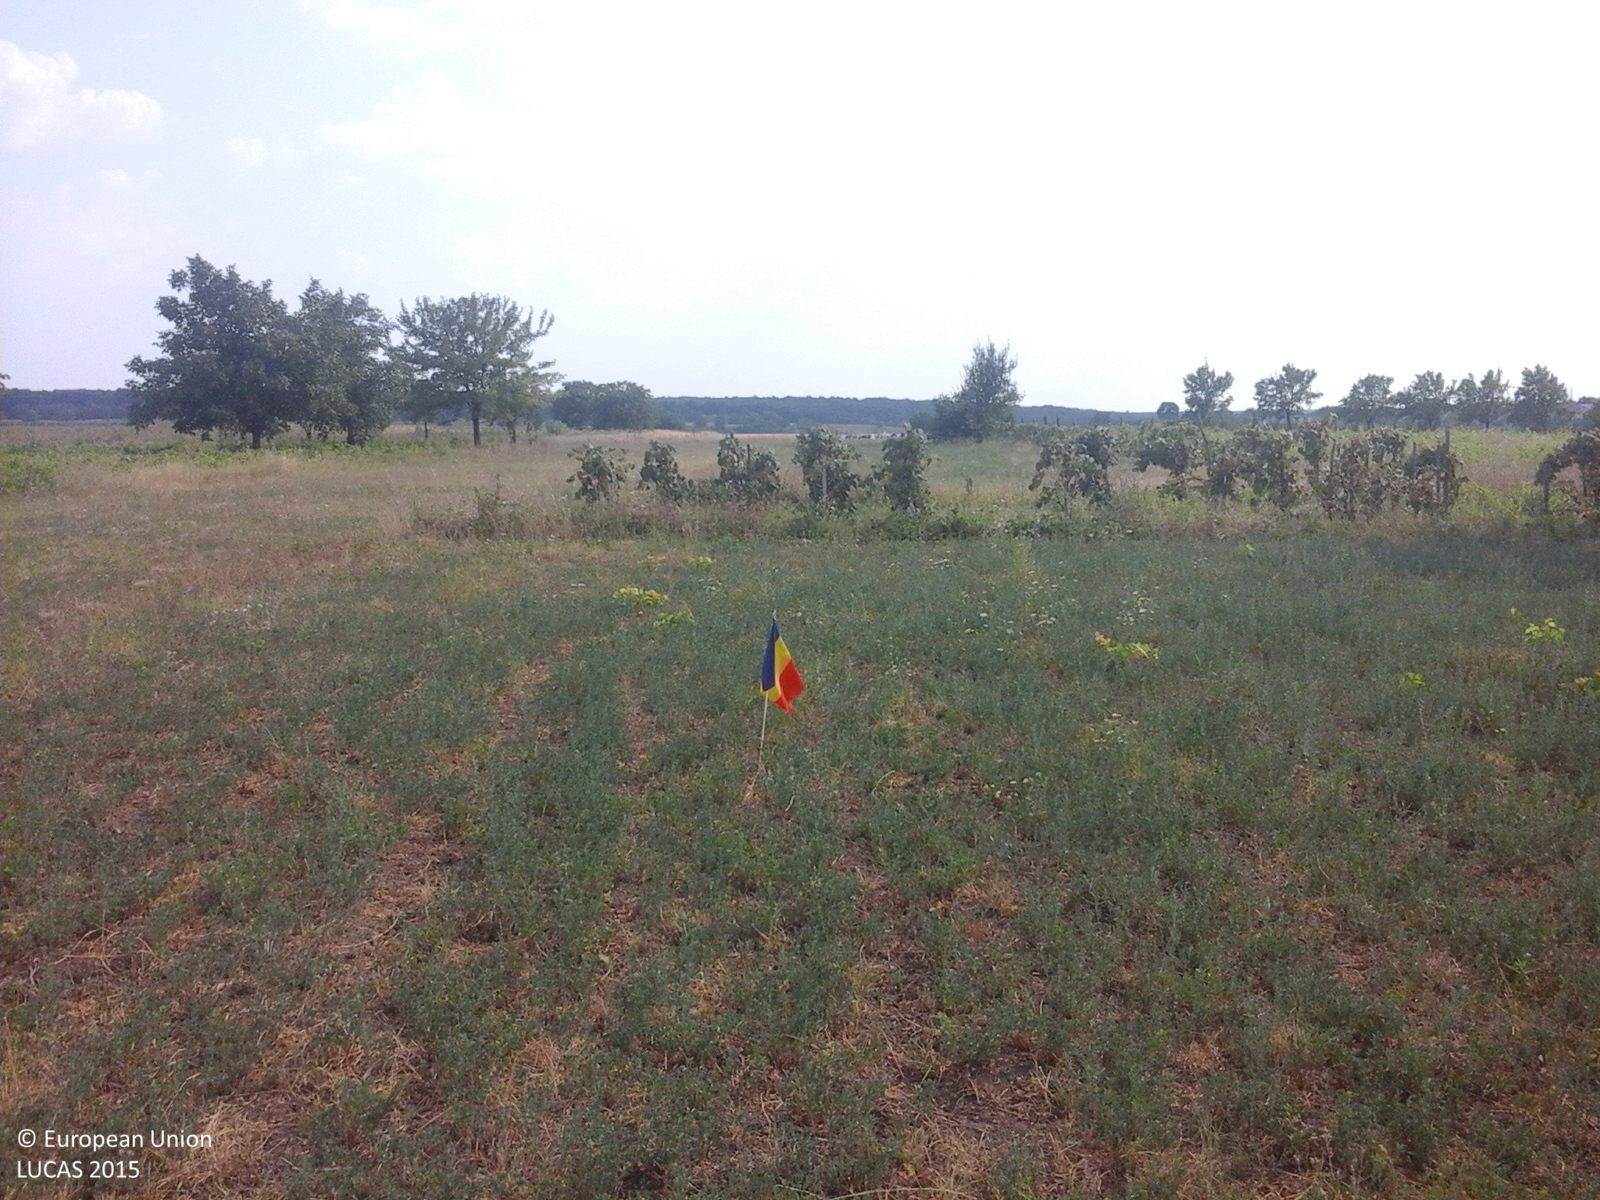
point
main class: Cropland
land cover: Lucerne
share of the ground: > 75 %
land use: Agriculture (excluding fallow land and kitchen gardens)
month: August
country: RO
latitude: 44.2891
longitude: 23.1927
